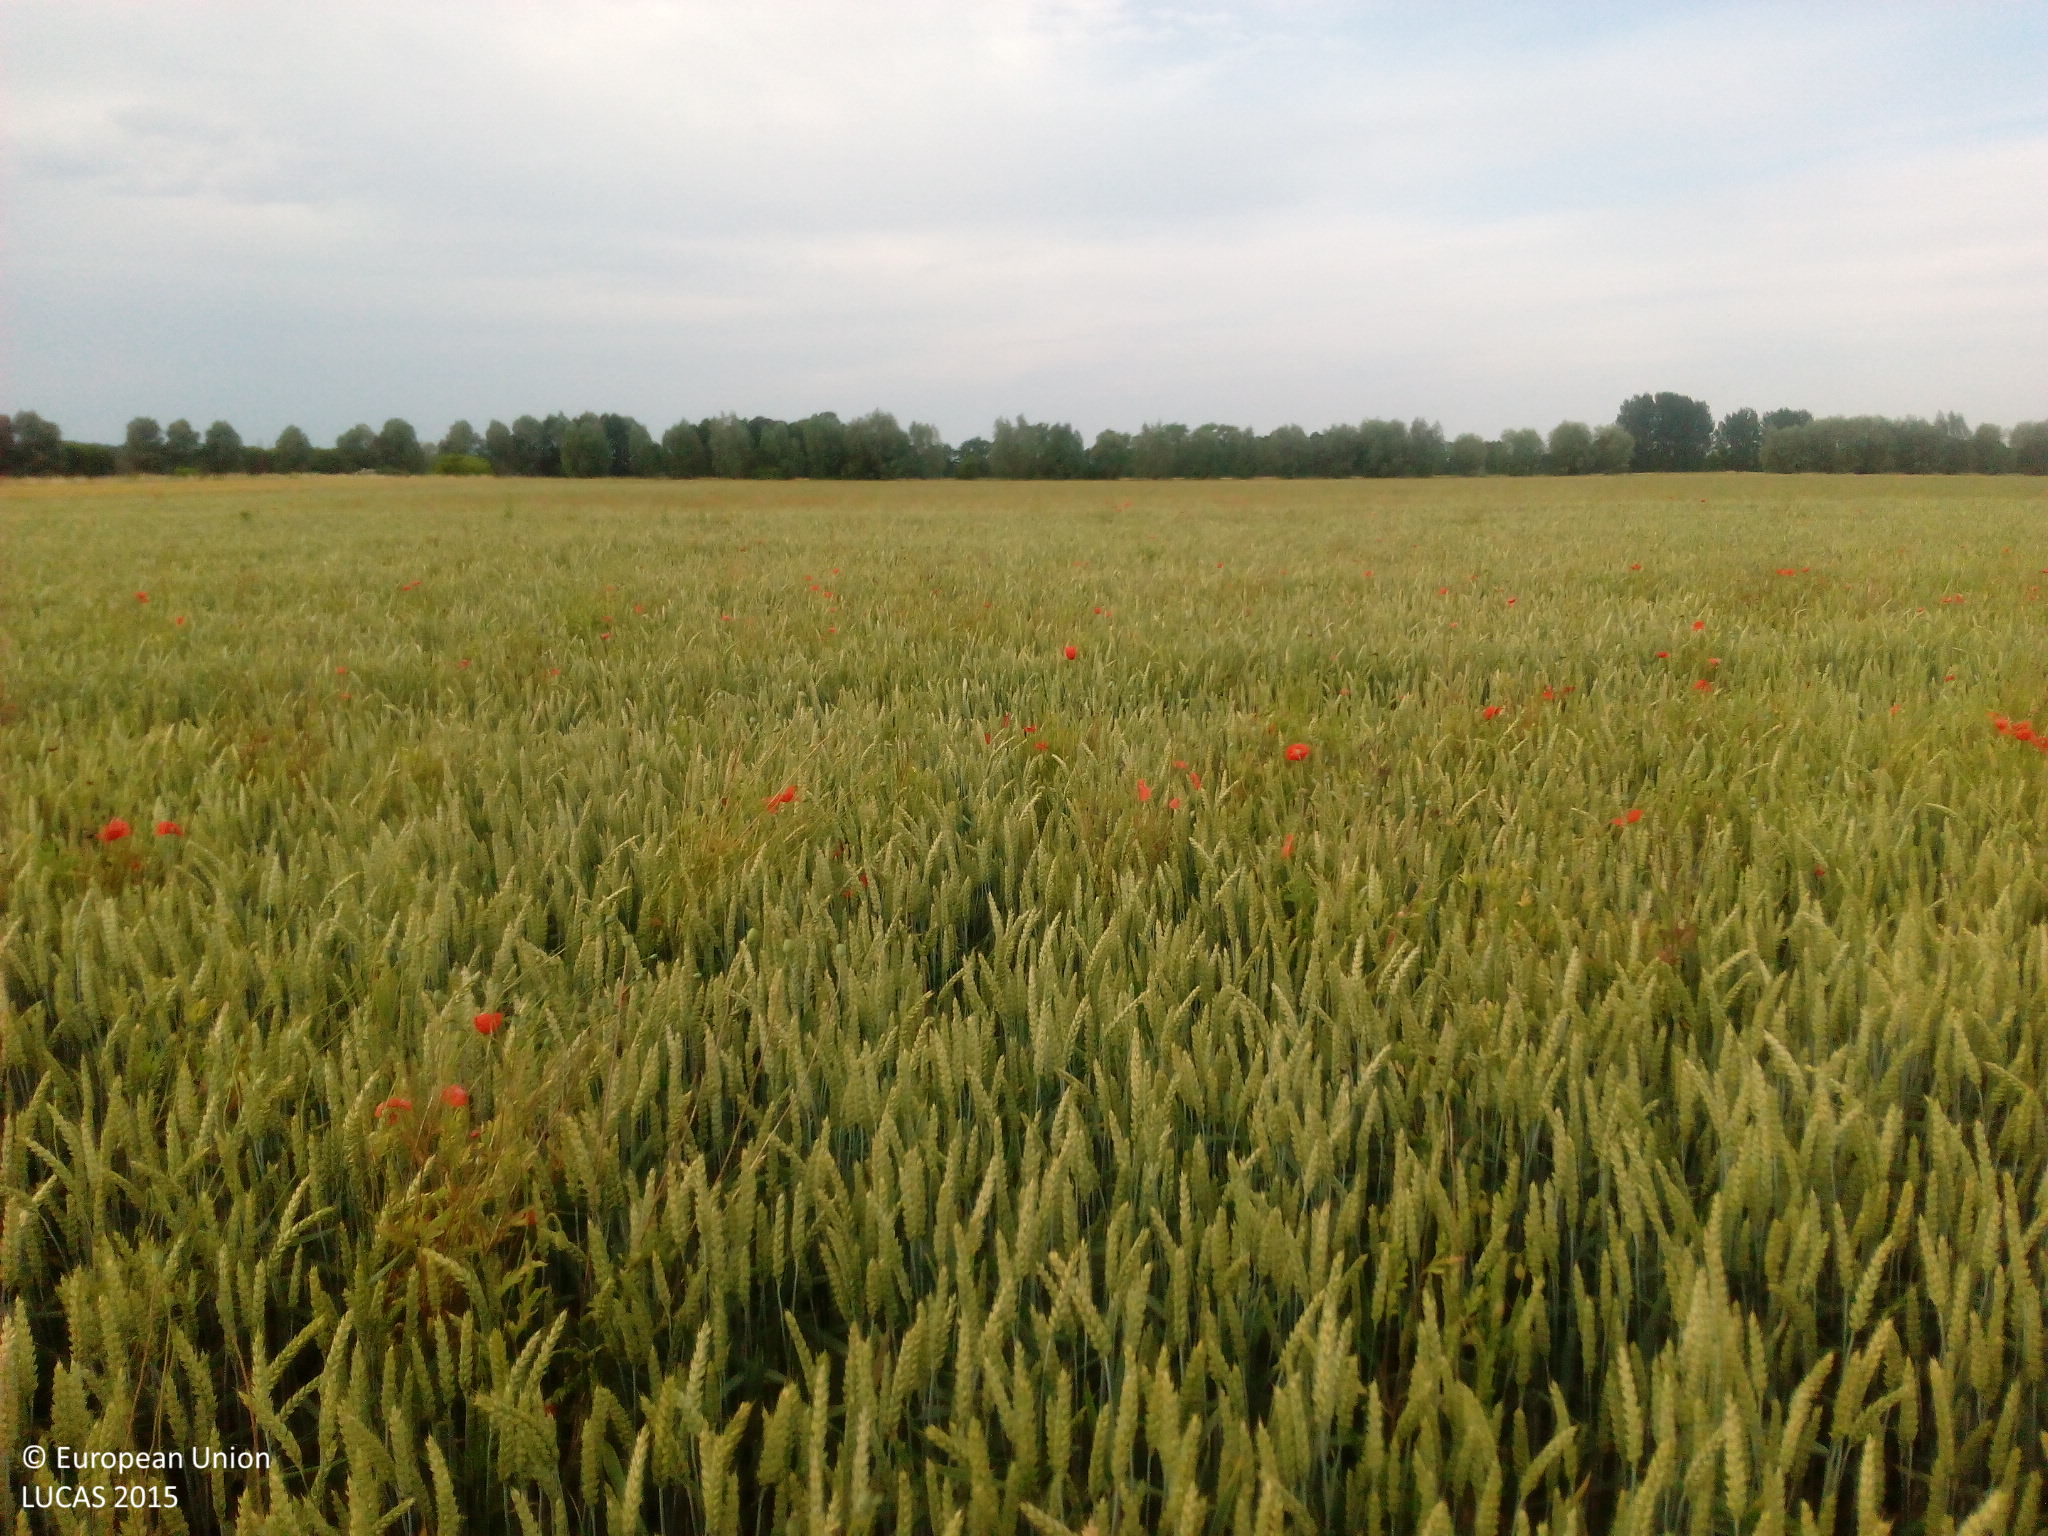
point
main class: Cropland
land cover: Common wheat
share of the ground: > 75 %
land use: Agriculture (excluding fallow land and kitchen gardens)
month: July
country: DE
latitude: 52.8024
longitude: 12.4173
